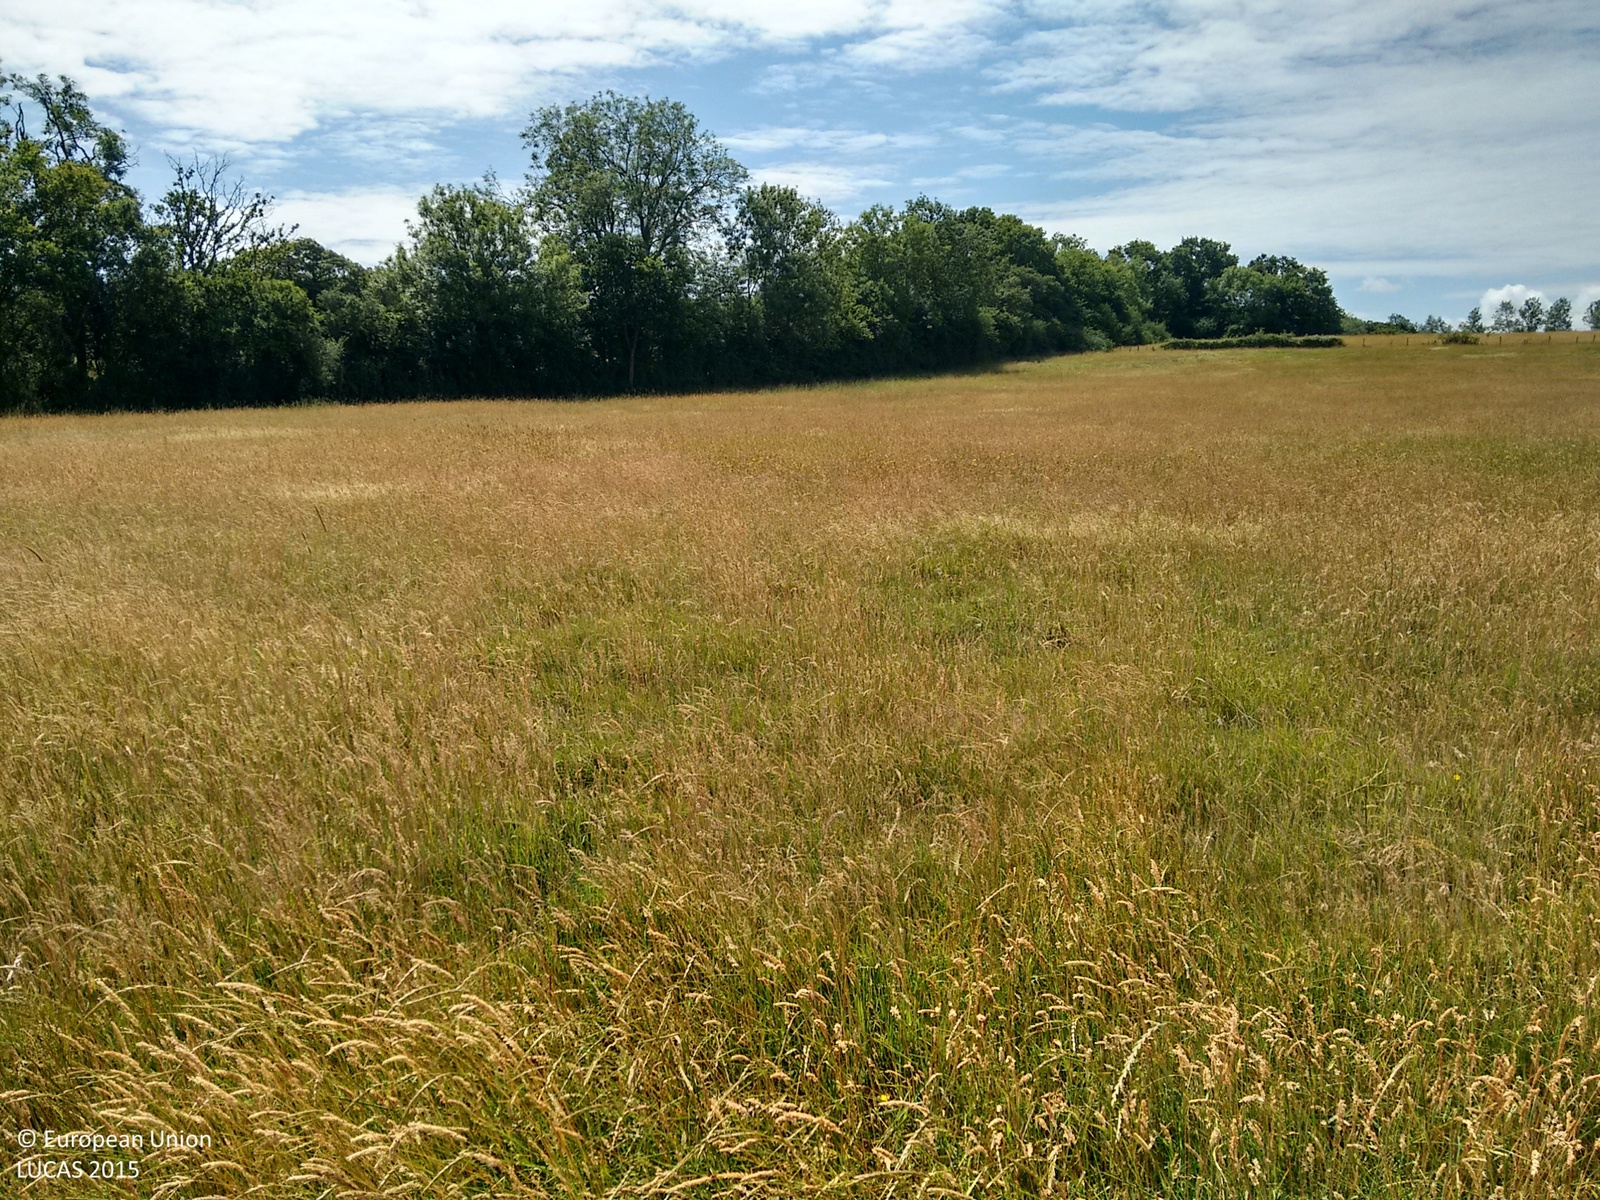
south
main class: Grassland
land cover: Grassland without tree/shrub cover
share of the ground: > 75 %
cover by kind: herbaceous plants 100 %
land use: Agriculture (excluding fallow land and kitchen gardens)
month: July
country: GB
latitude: 51.0103
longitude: -0.4278
